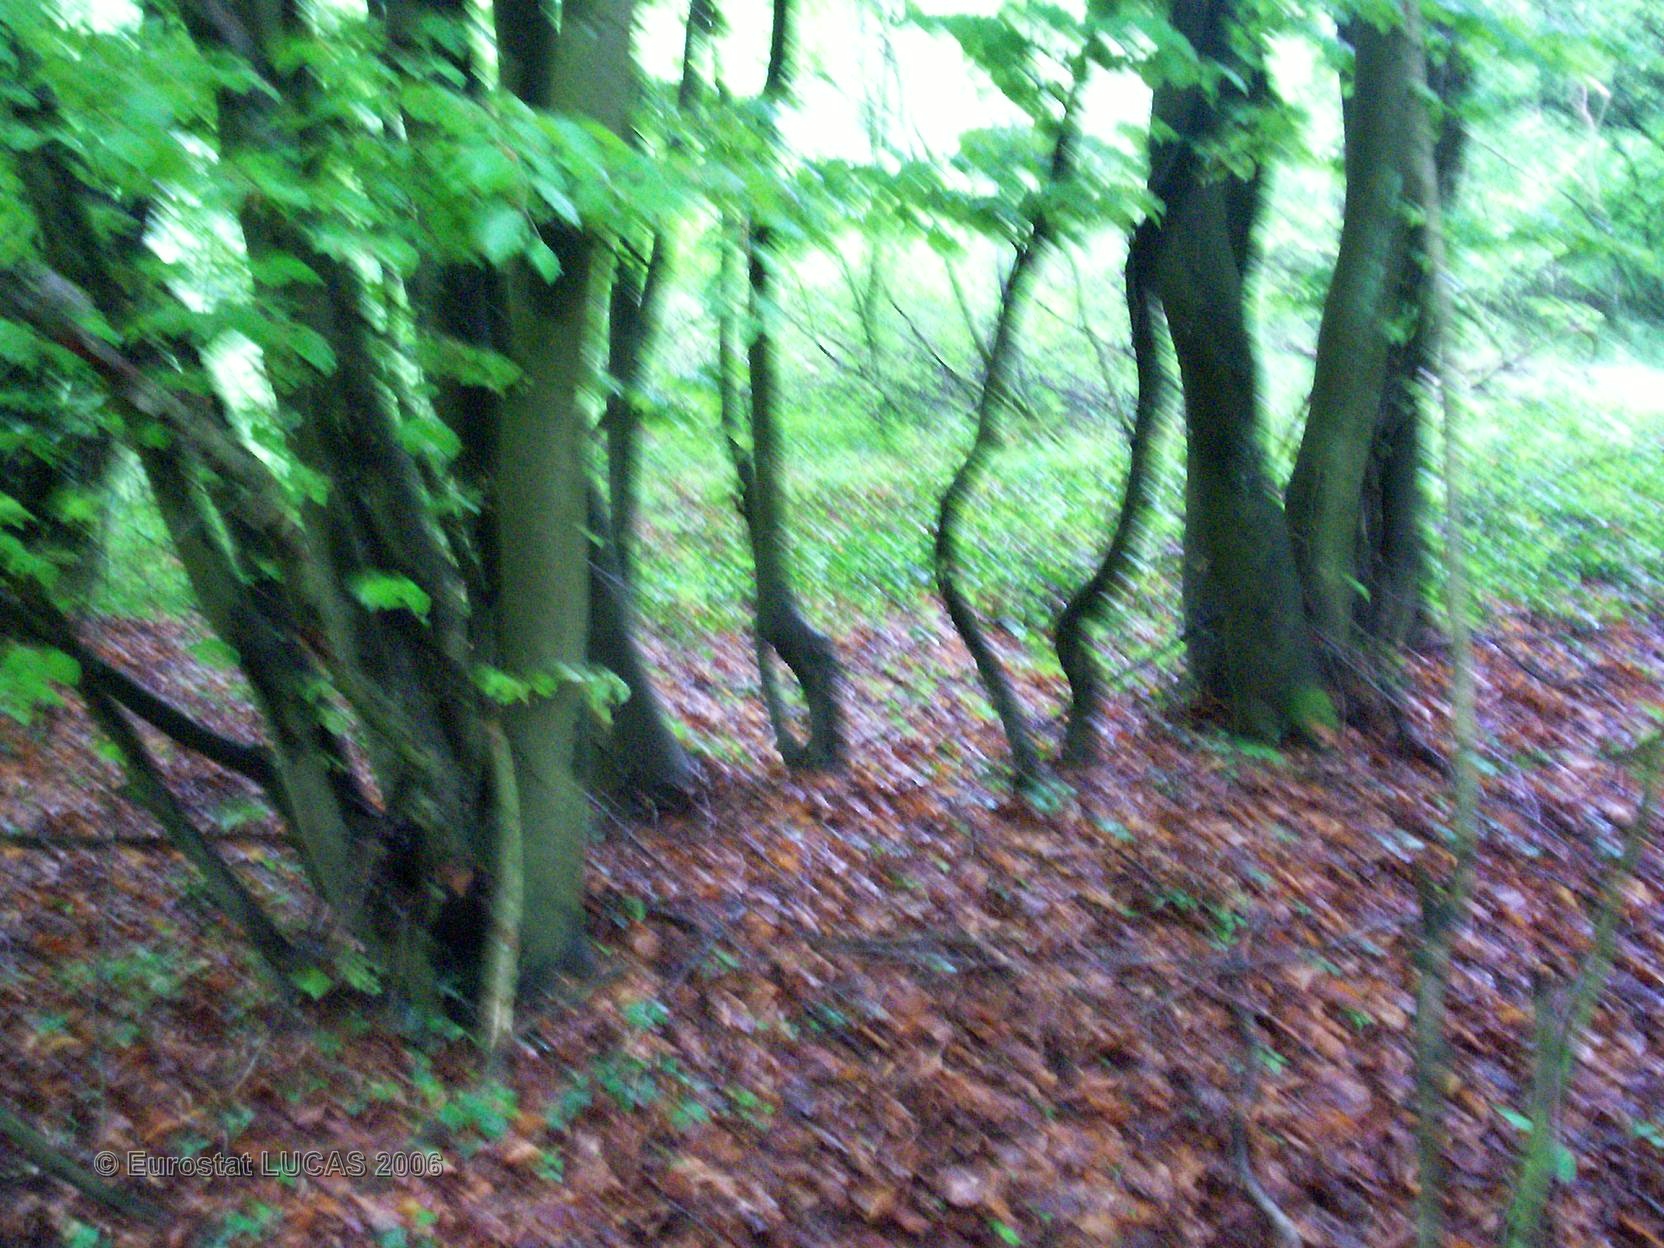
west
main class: Woodland
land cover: Broadleaved forest
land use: Forestry
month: May
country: FR
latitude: 49.3176
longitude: 6.4093
